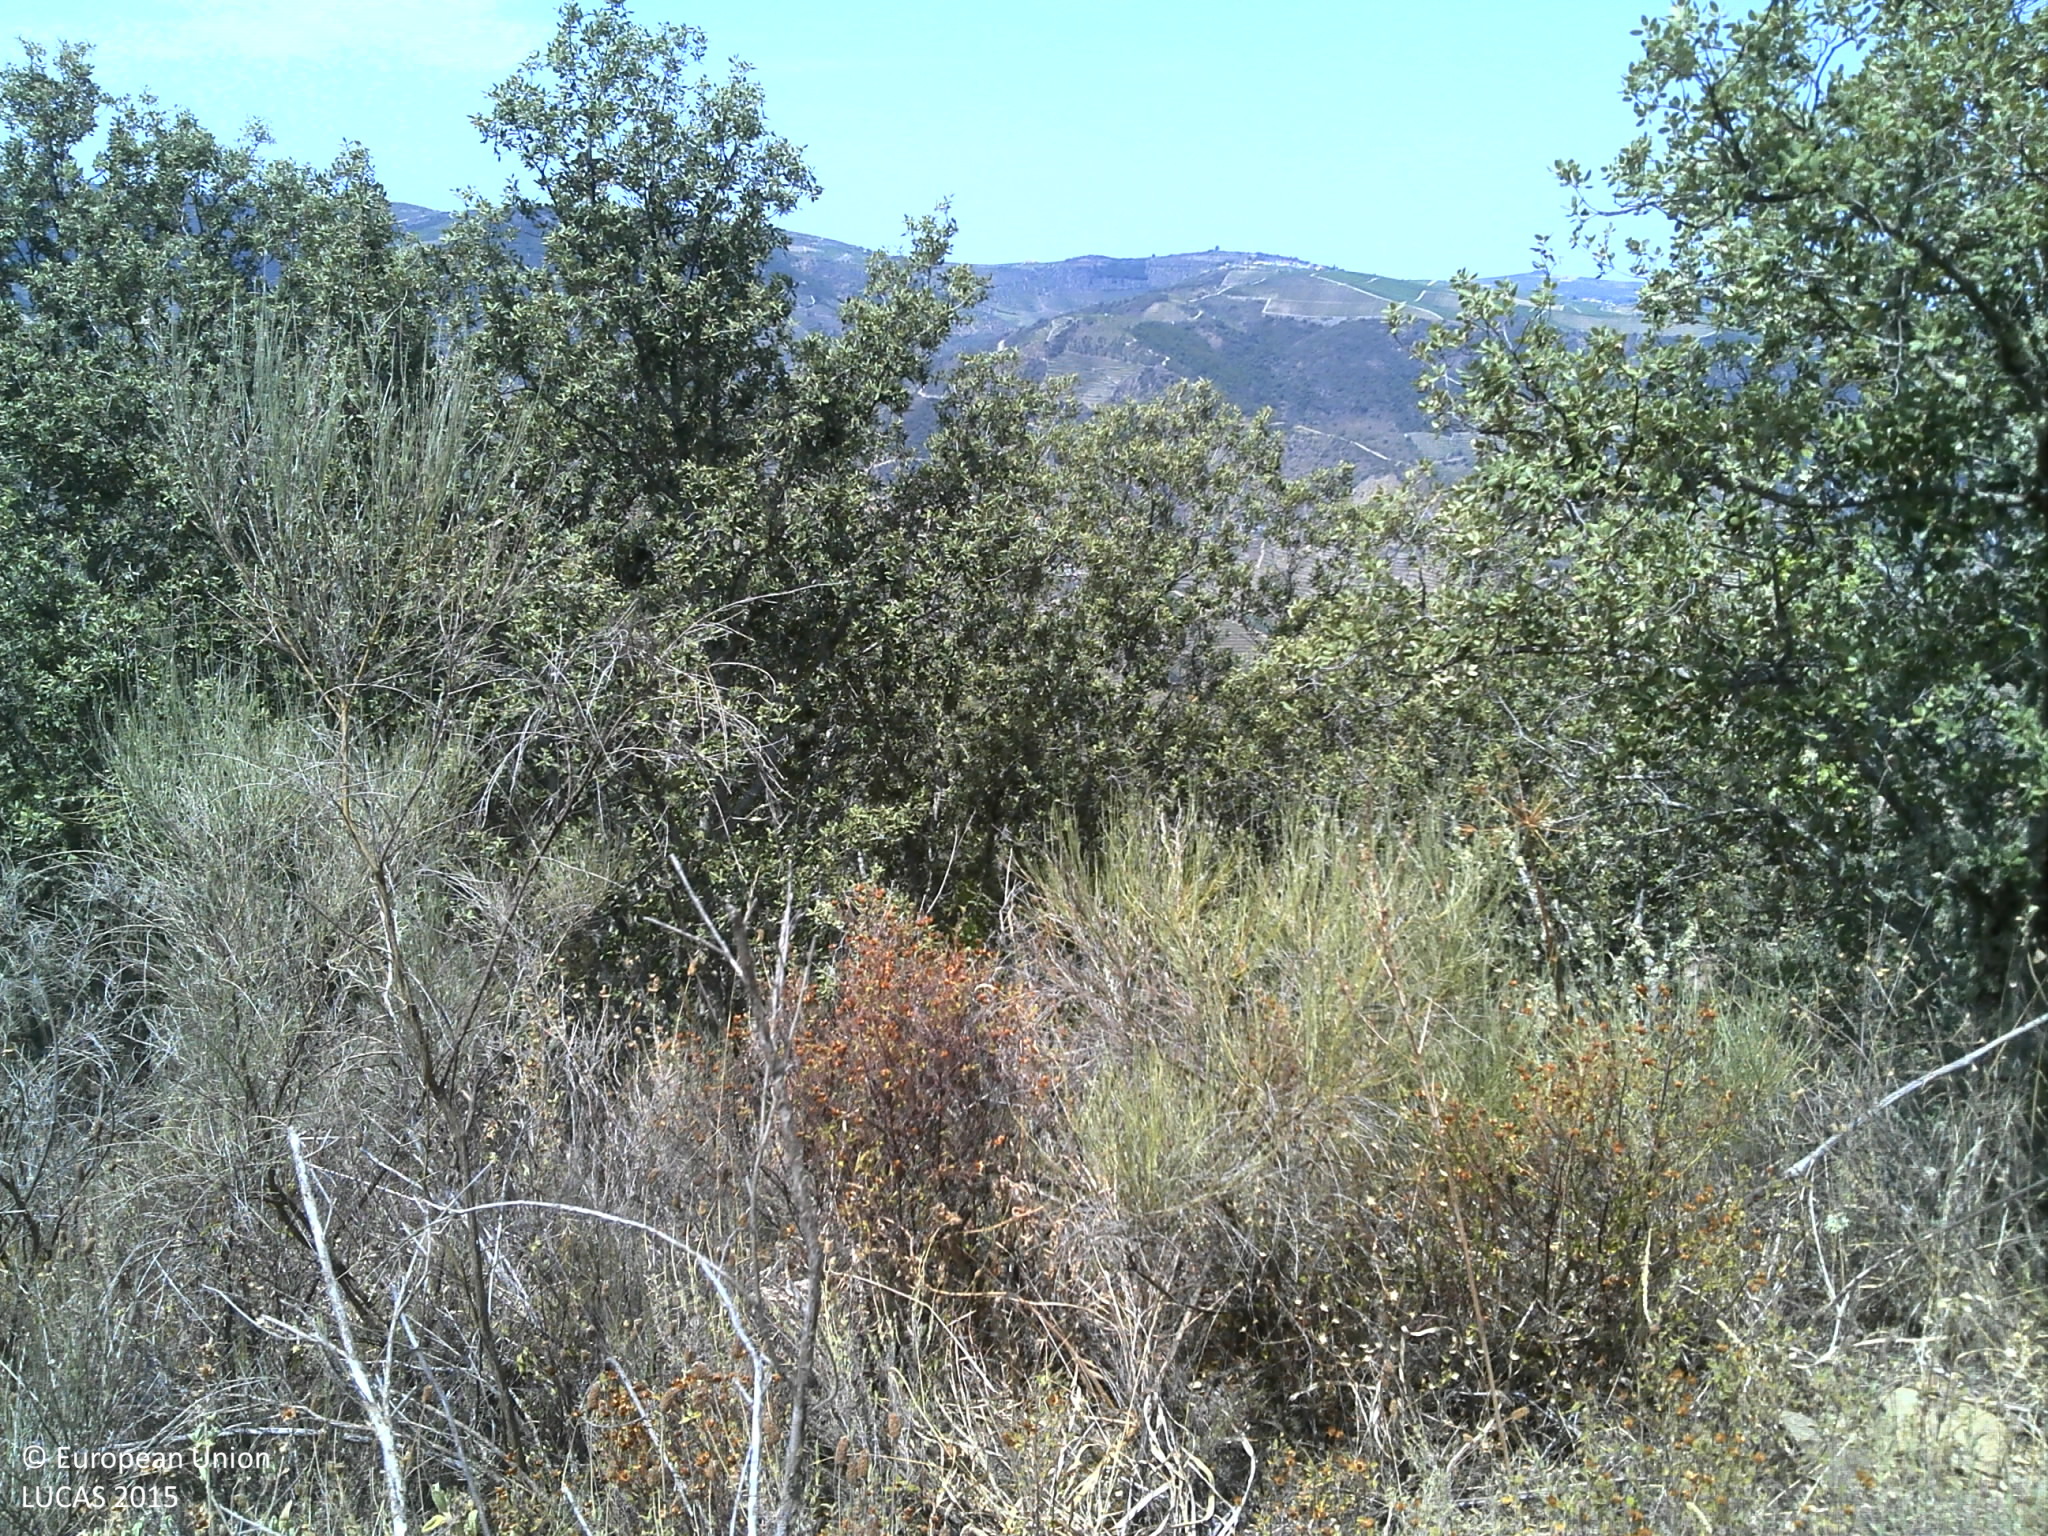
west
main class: Woodland
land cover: Broadleaved woodland
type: broadleaved evergreen forest
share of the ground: 10 - 25 %
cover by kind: shrubs 70 %, broadleaved forest trees 20 %, coniferous forest trees 5 %, unconsolidated bare surface 5 %
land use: Semi-natural and natural areas not in use
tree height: < 5 m
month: July
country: PT
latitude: 41.1284
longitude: -7.3293
